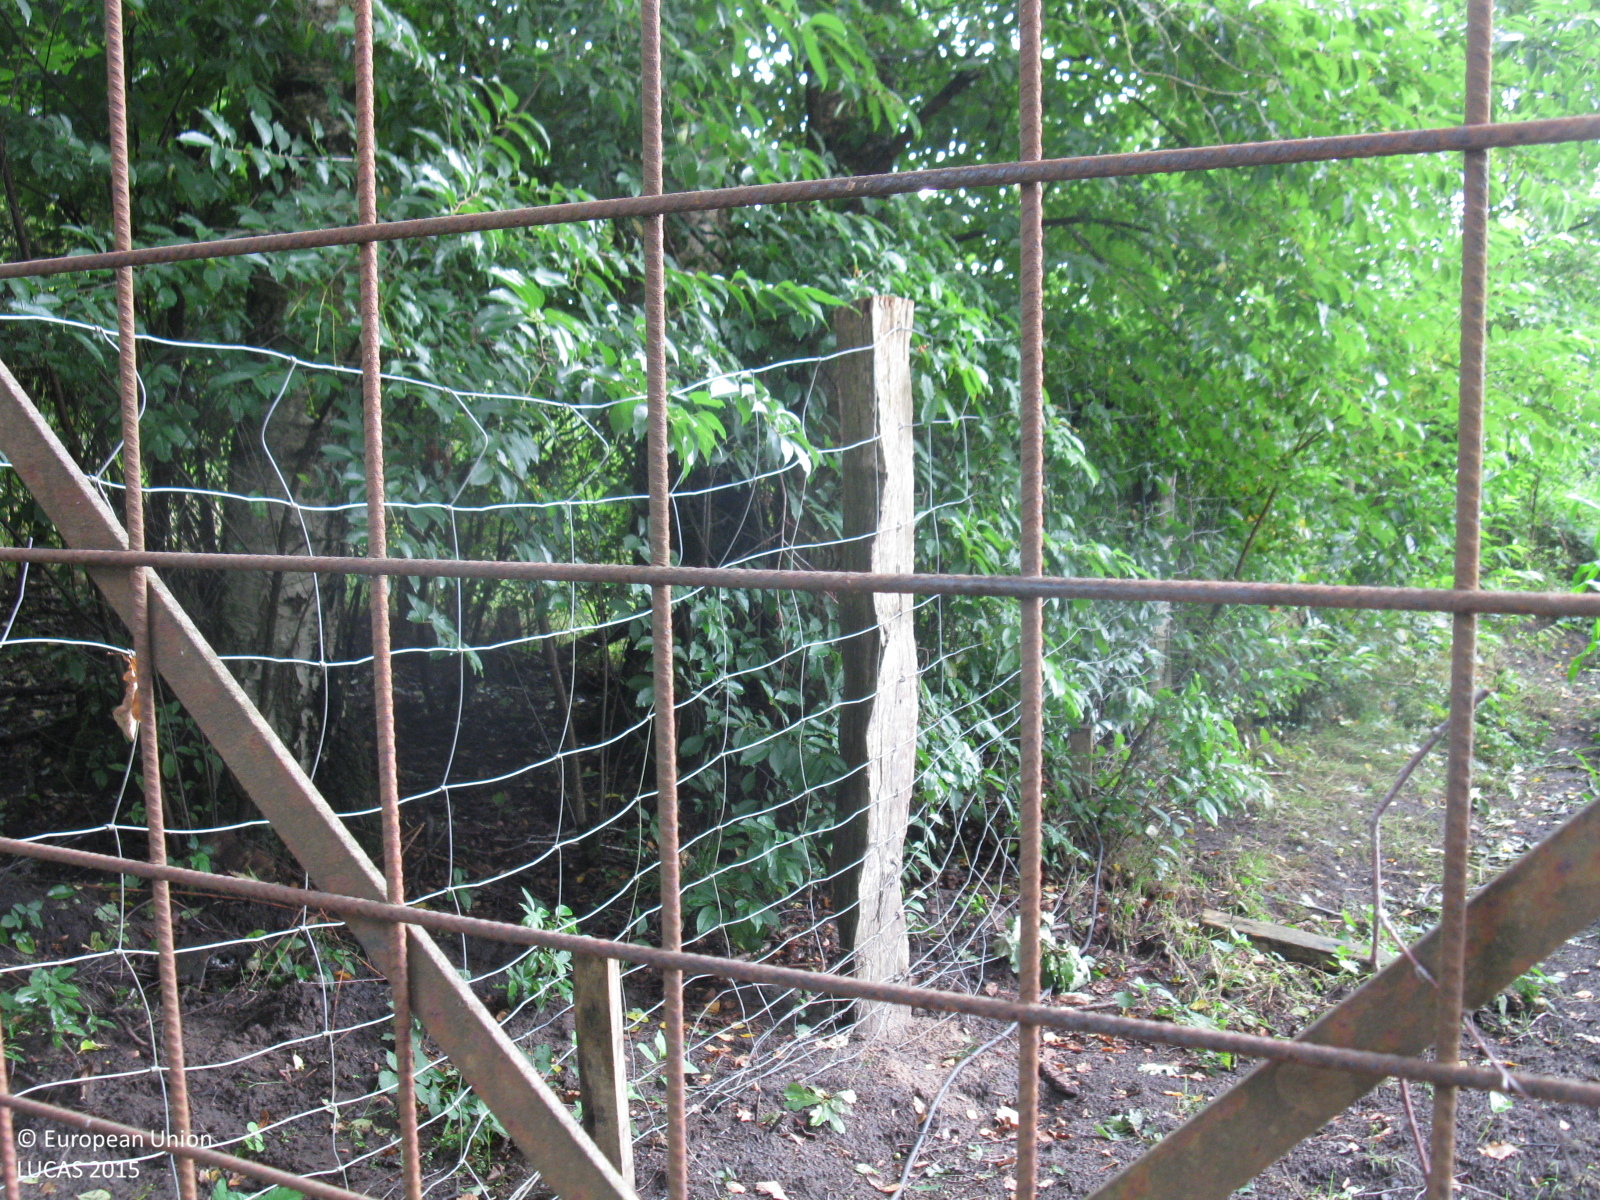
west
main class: Cropland
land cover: Maize
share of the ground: > 75 %
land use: Agriculture (excluding fallow land and kitchen gardens)
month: August
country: DE
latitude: 51.7266
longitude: 6.9452
